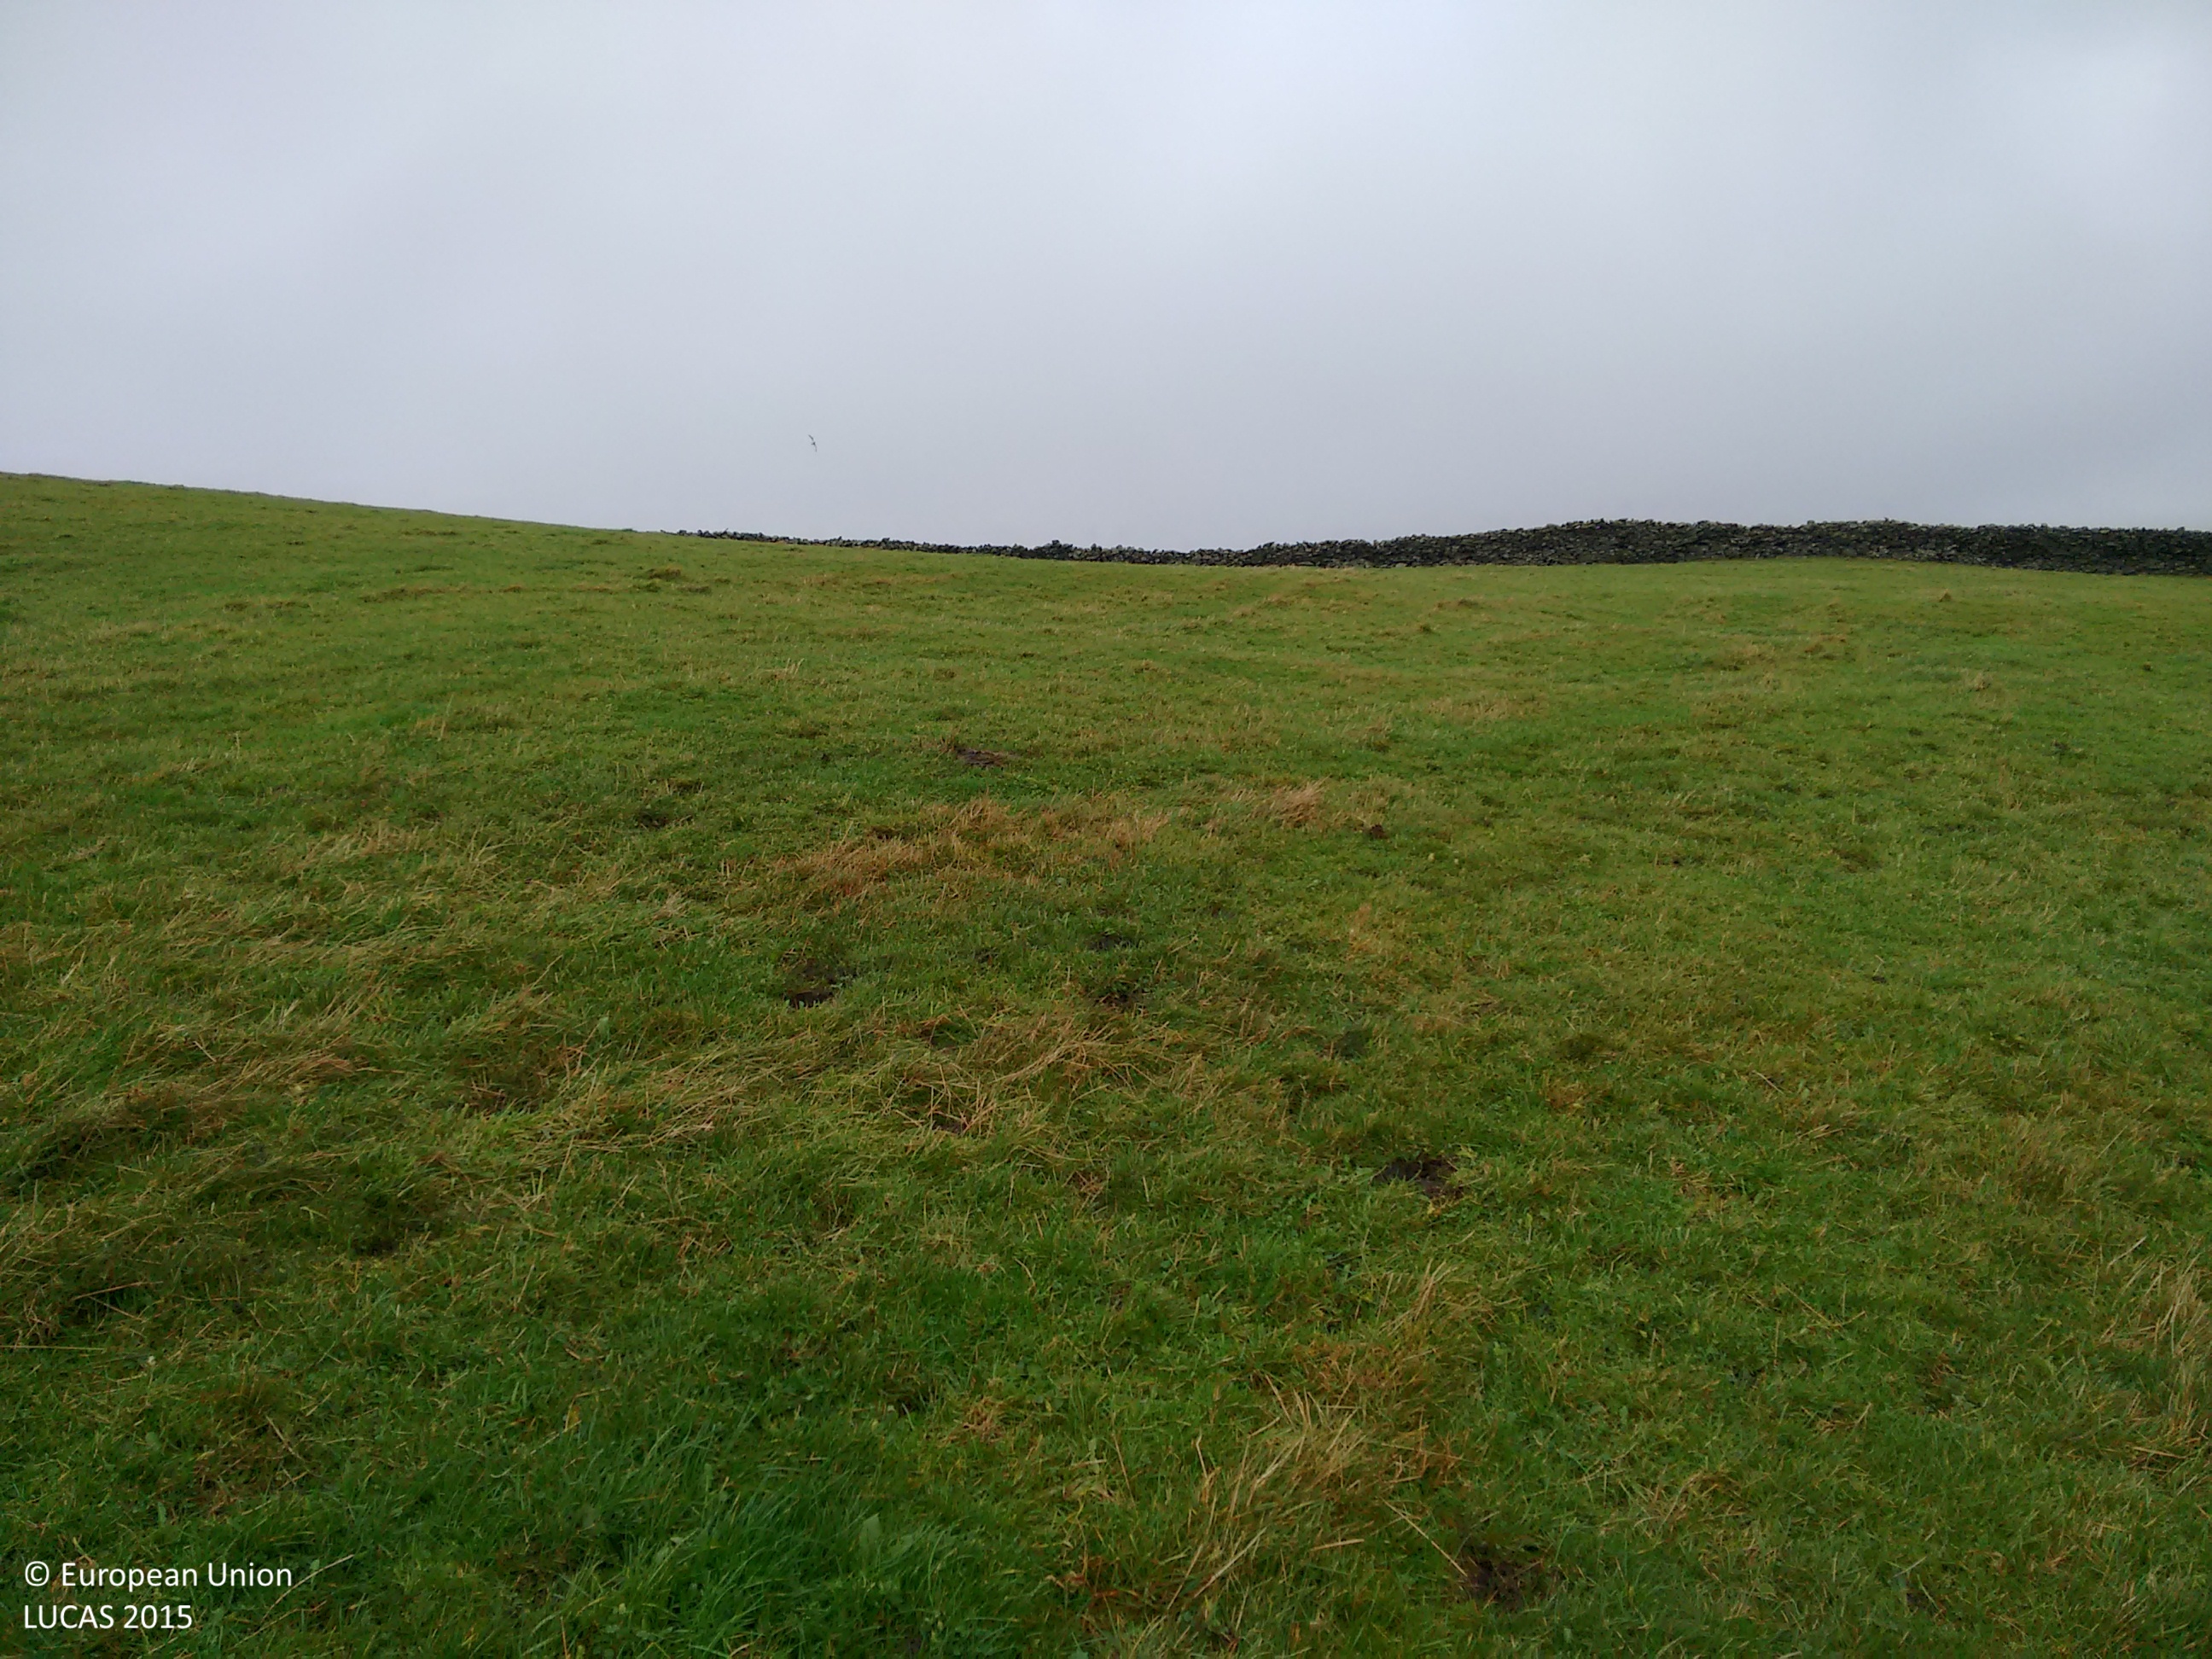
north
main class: Grassland
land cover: Grassland without tree/shrub cover
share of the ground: > 75 %
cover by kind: herbaceous plants 100 %
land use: Agriculture (excluding fallow land and kitchen gardens)
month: November
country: GB
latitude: 54.1940
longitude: -3.1498
